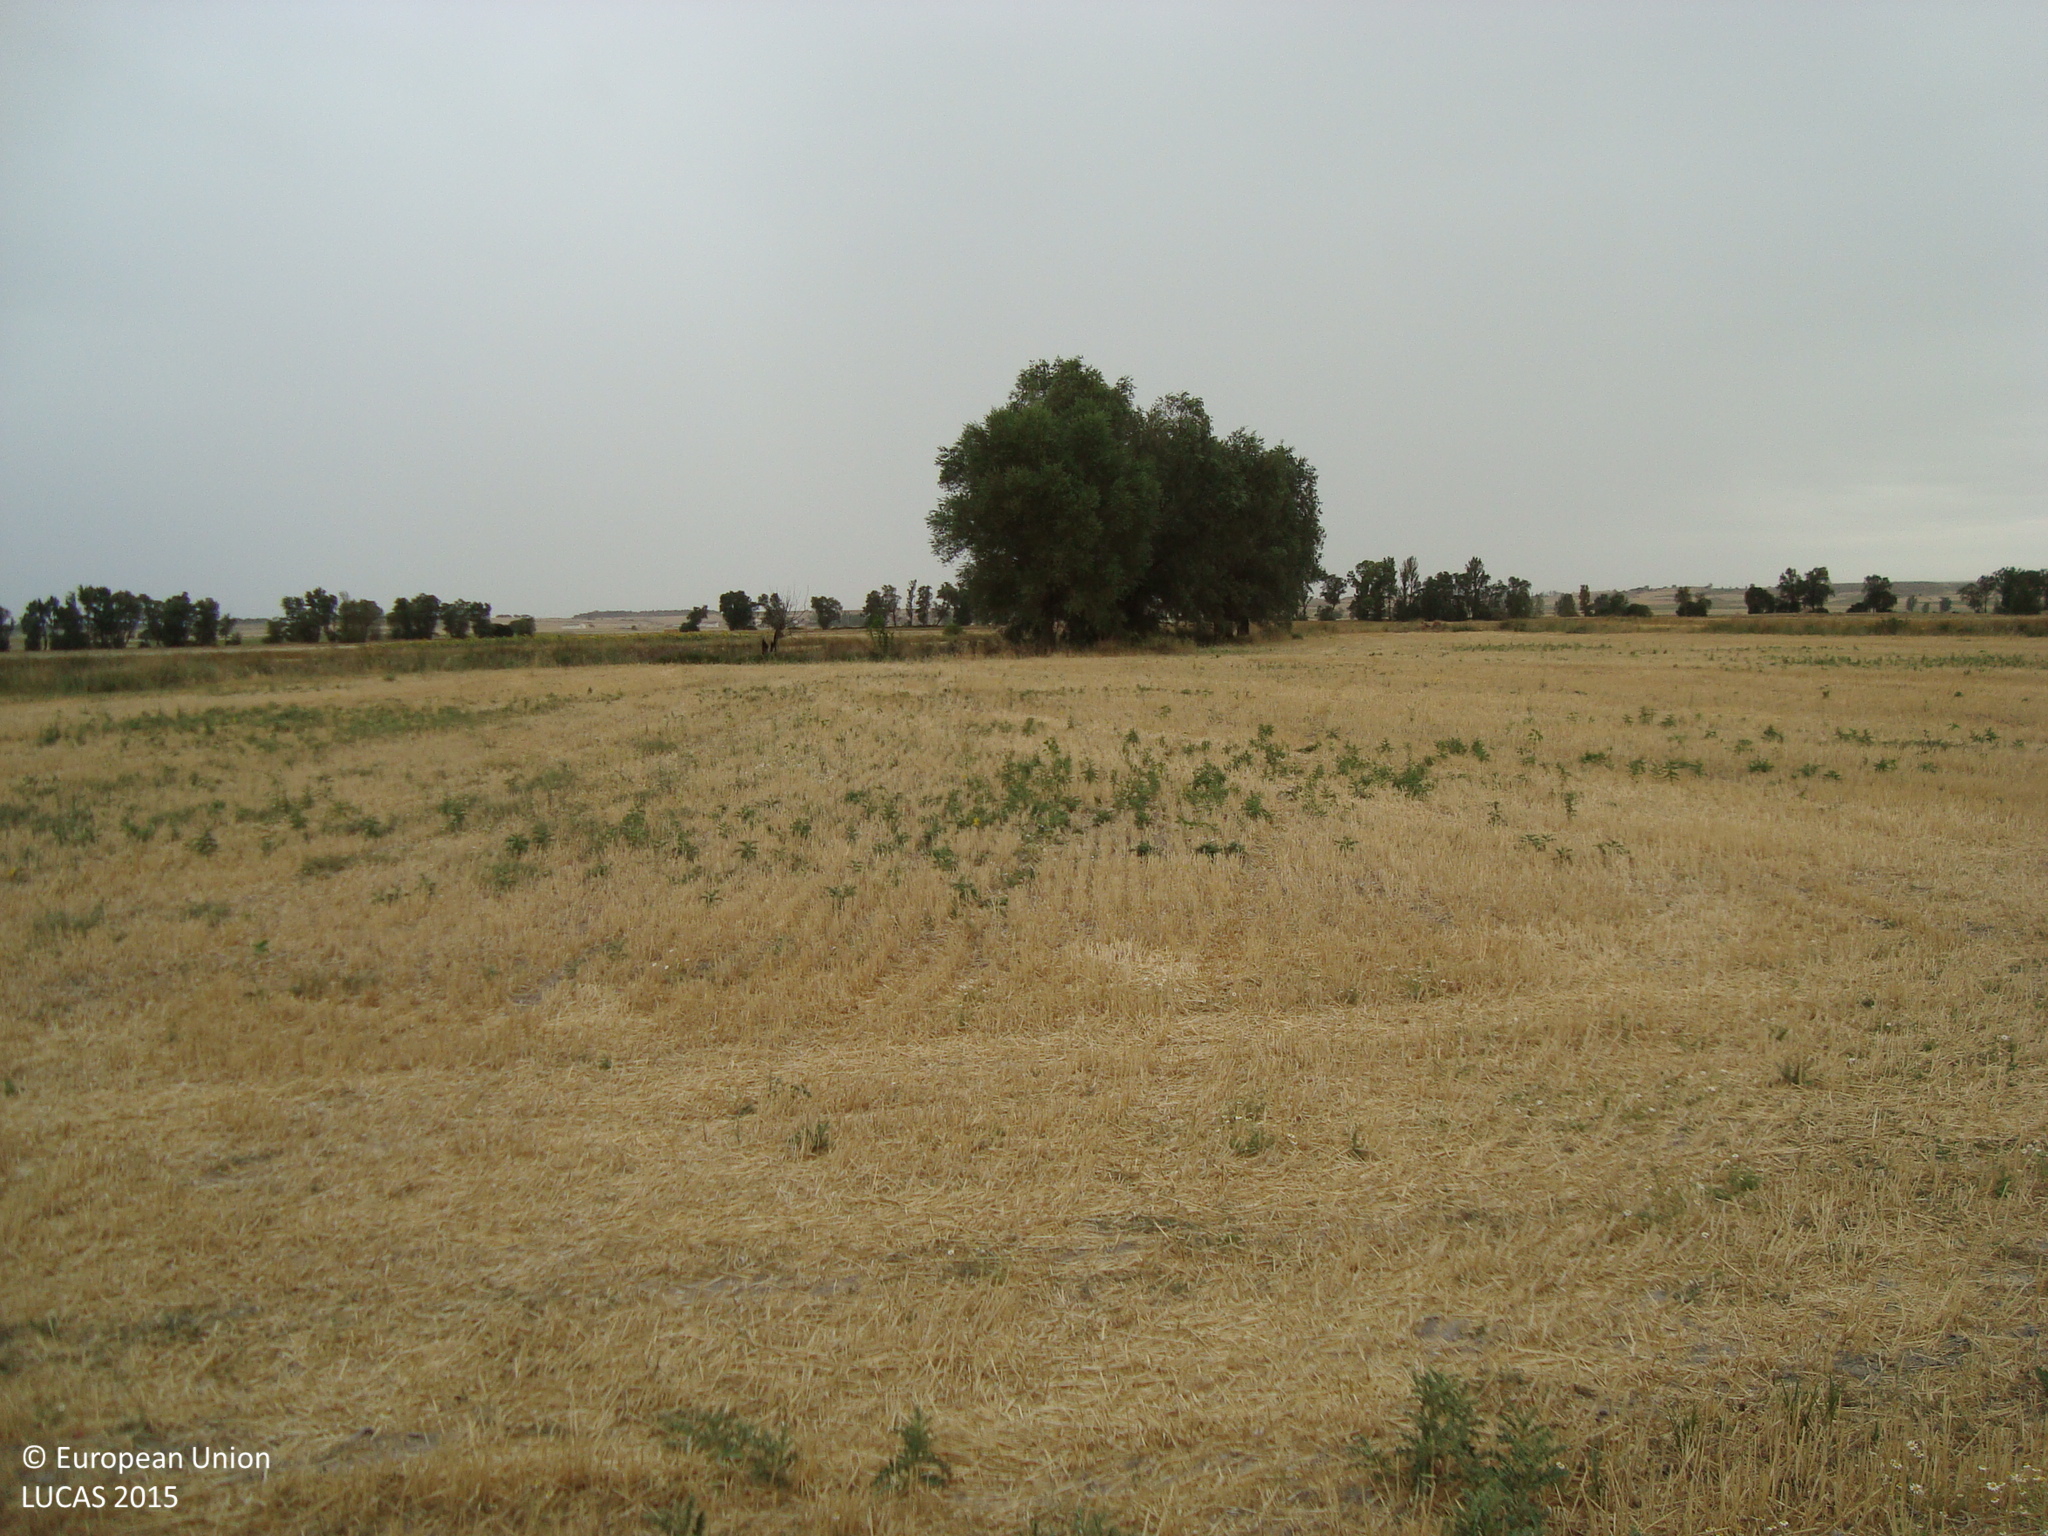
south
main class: Cropland
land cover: Barley
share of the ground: > 75 %
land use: Agriculture (excluding fallow land and kitchen gardens)
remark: Harvested field
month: August
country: ES
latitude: 42.1809
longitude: -3.9249
